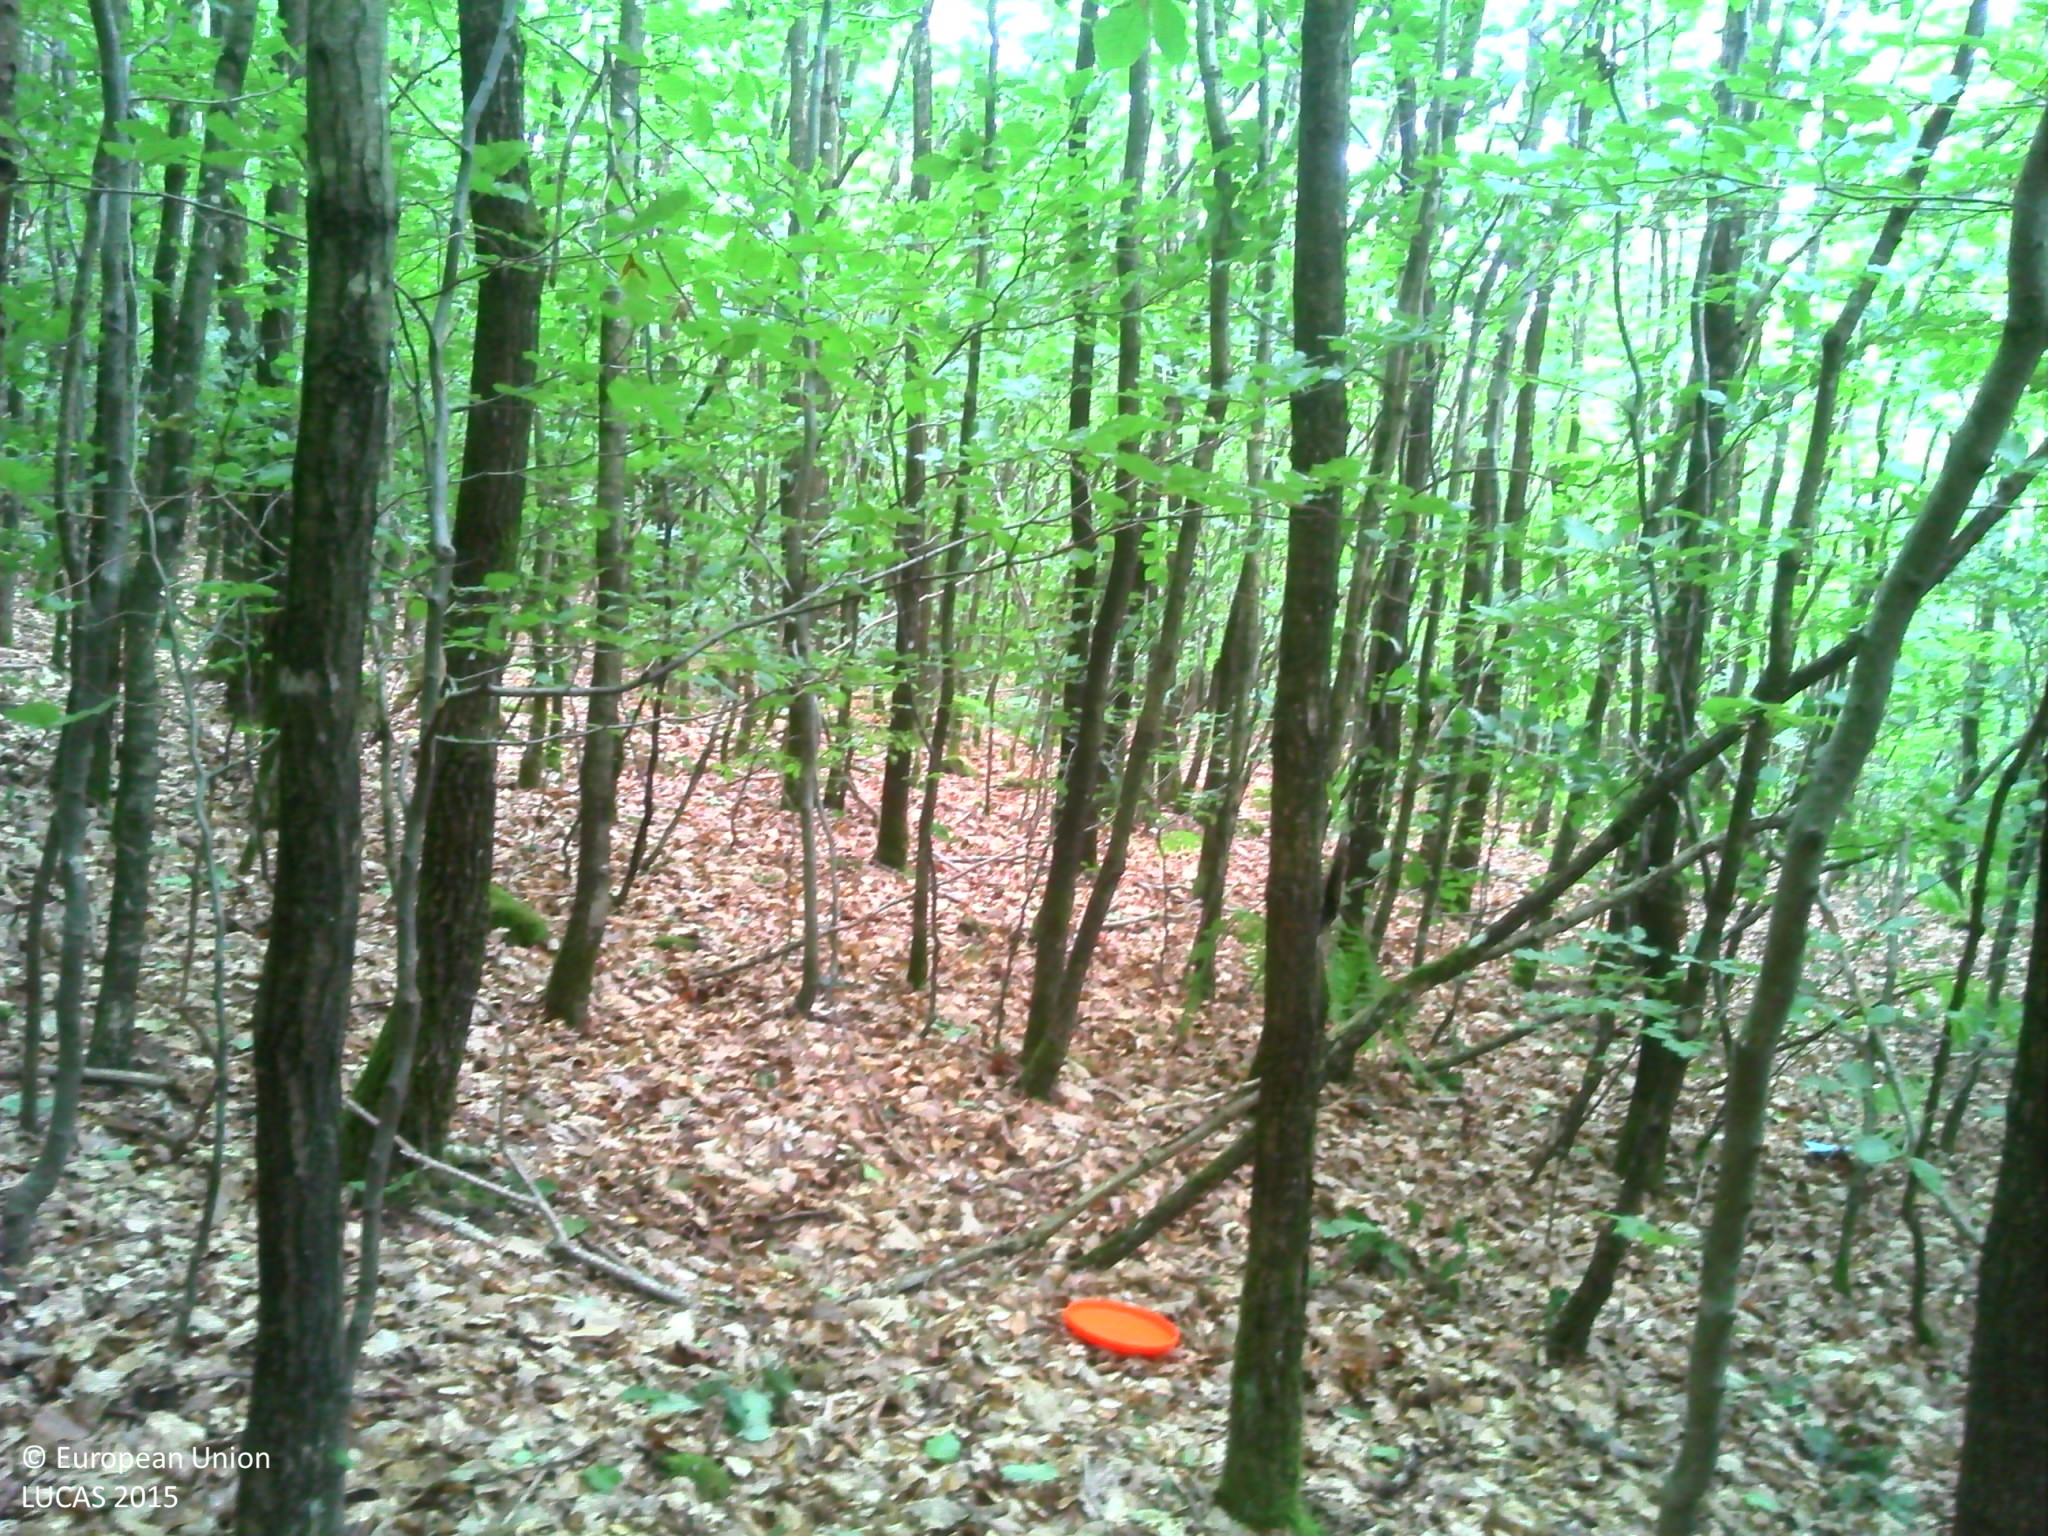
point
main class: Woodland
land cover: Broadleaved woodland
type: beech forest
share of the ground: > 75 %
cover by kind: broadleaved forest trees 100 %
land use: Forestry
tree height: > 5 m
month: July
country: FR
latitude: 48.9339
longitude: 7.5298
